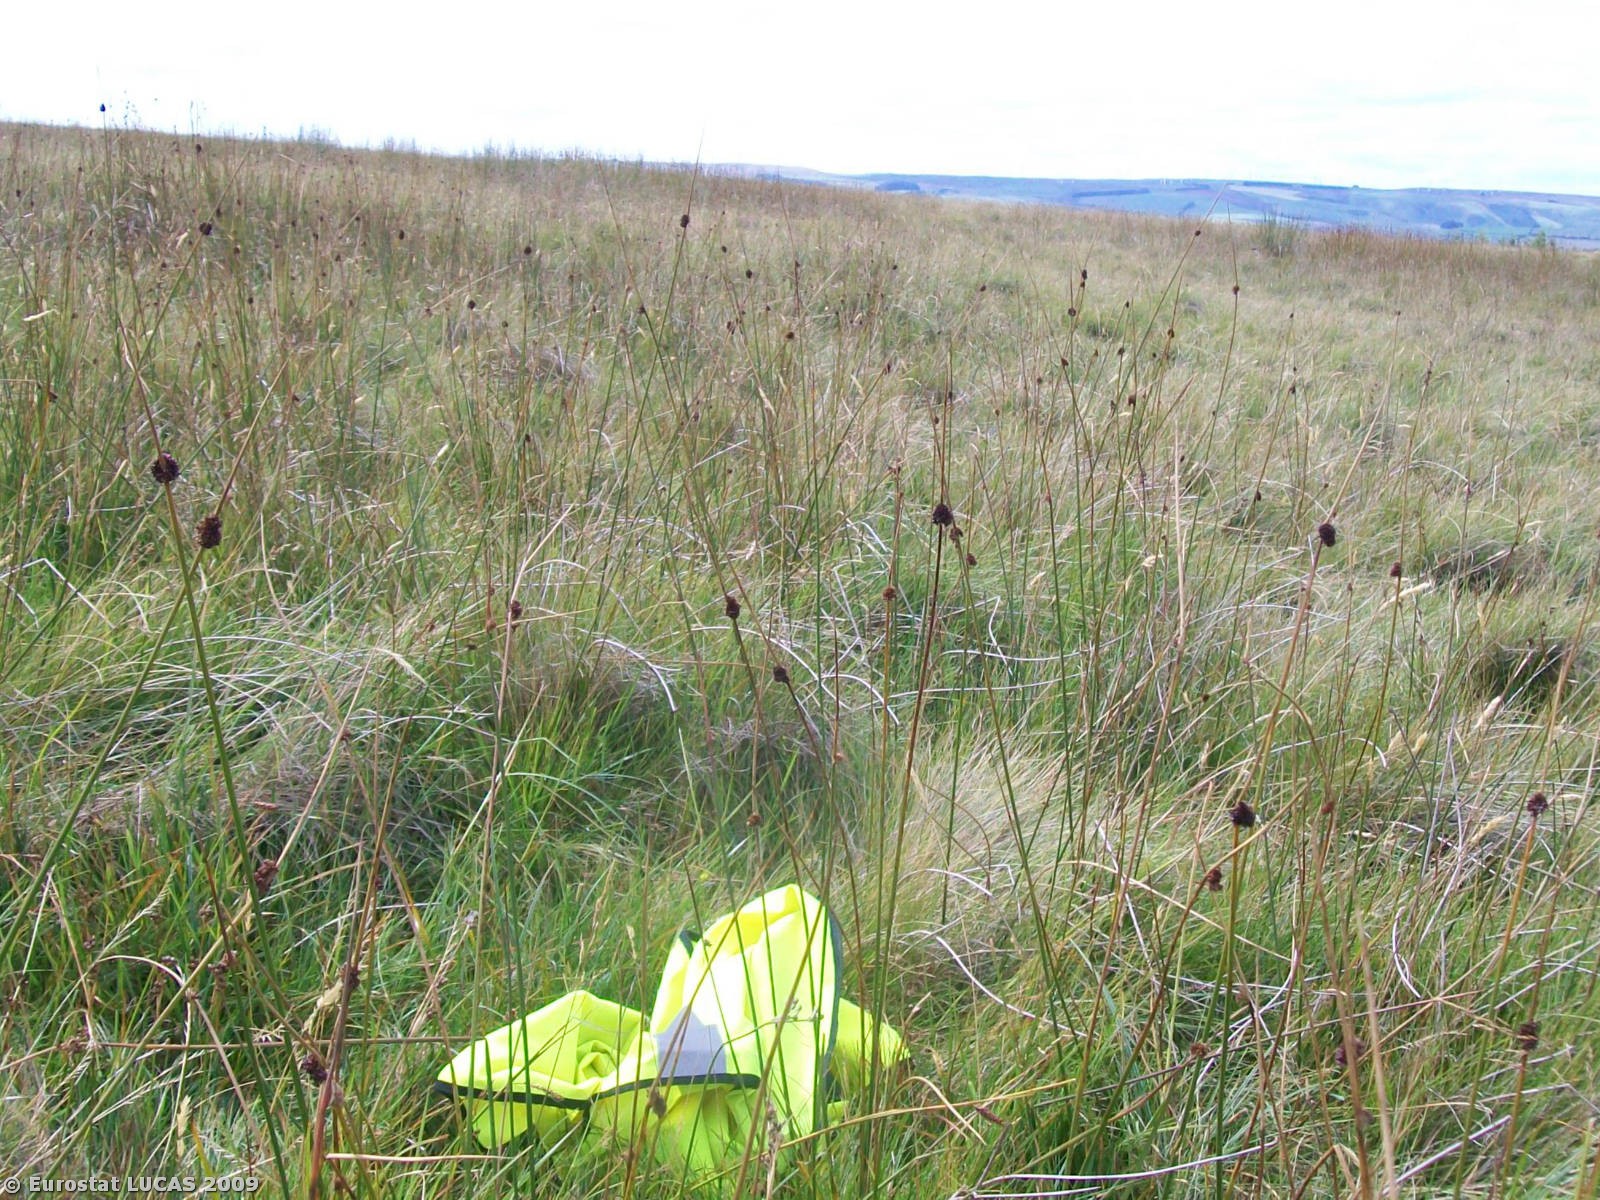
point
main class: Grassland
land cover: Grassland without tree/shrub cover
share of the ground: > 75 %
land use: Agriculture (excluding fallow land and kitchen gardens)
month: August
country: GB
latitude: 52.4444
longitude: -3.3070
